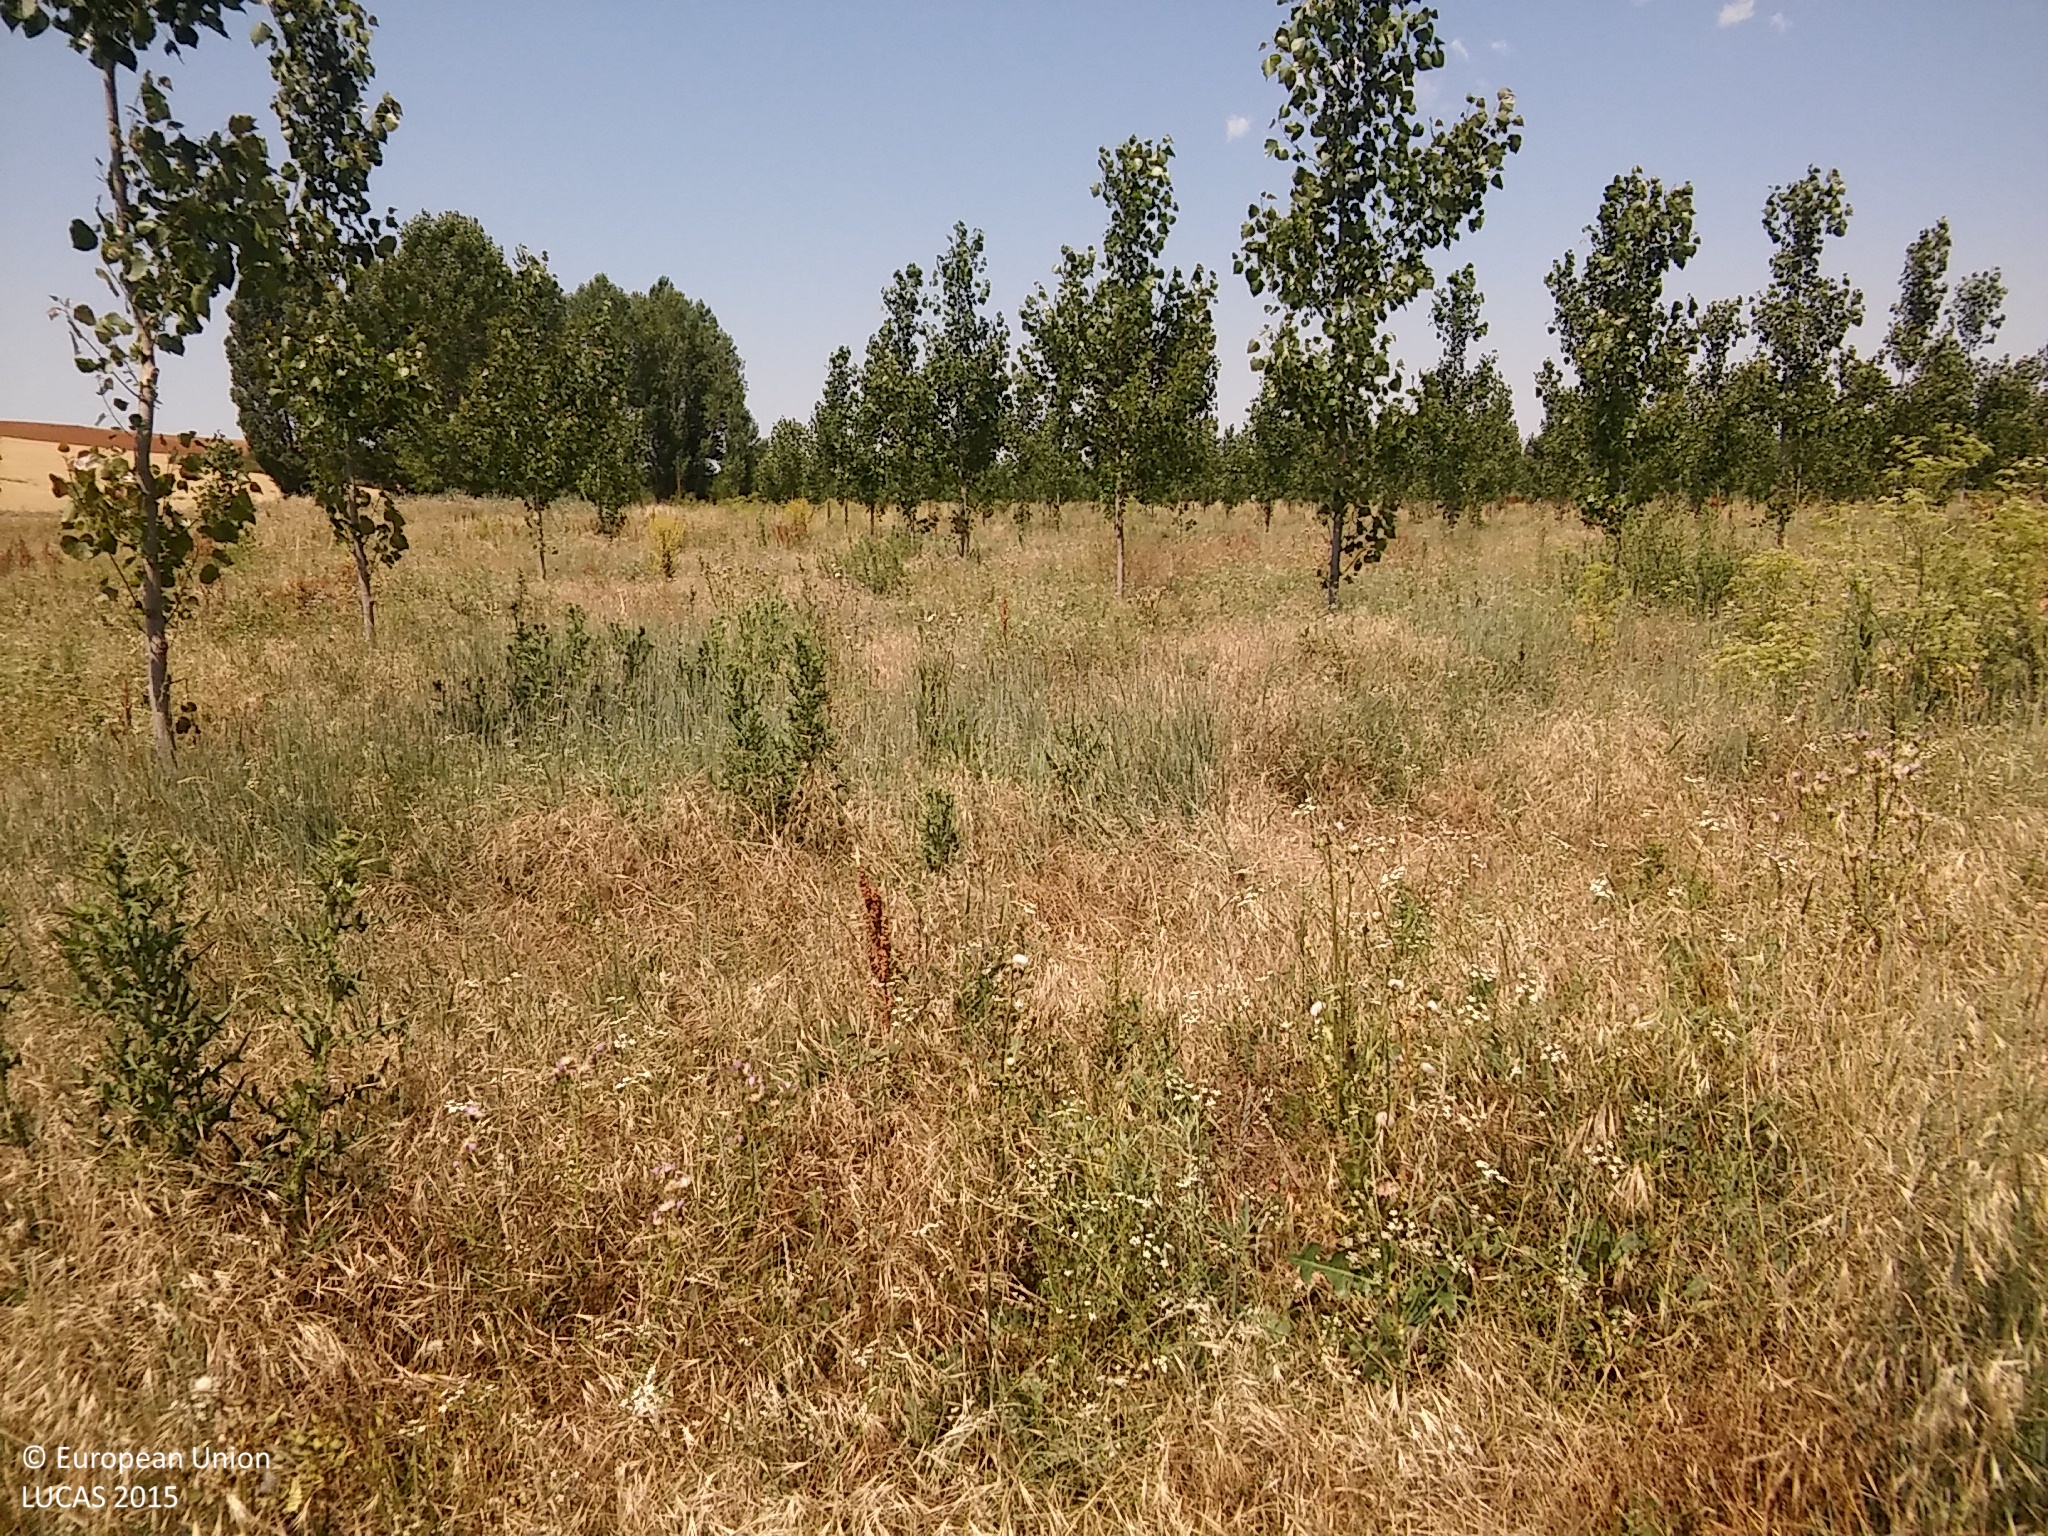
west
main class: Woodland
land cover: Broadleaved woodland
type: exotic forest
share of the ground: 10 - 25 %
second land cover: Grassland without tree/shrub cover
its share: > 75 %
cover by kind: herbaceous plants 75 %, broadleaved forest trees 15 %, shrubs 10 %
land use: Forestry
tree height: > 5 m
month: June
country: ES
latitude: 41.4203
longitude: -3.6048
